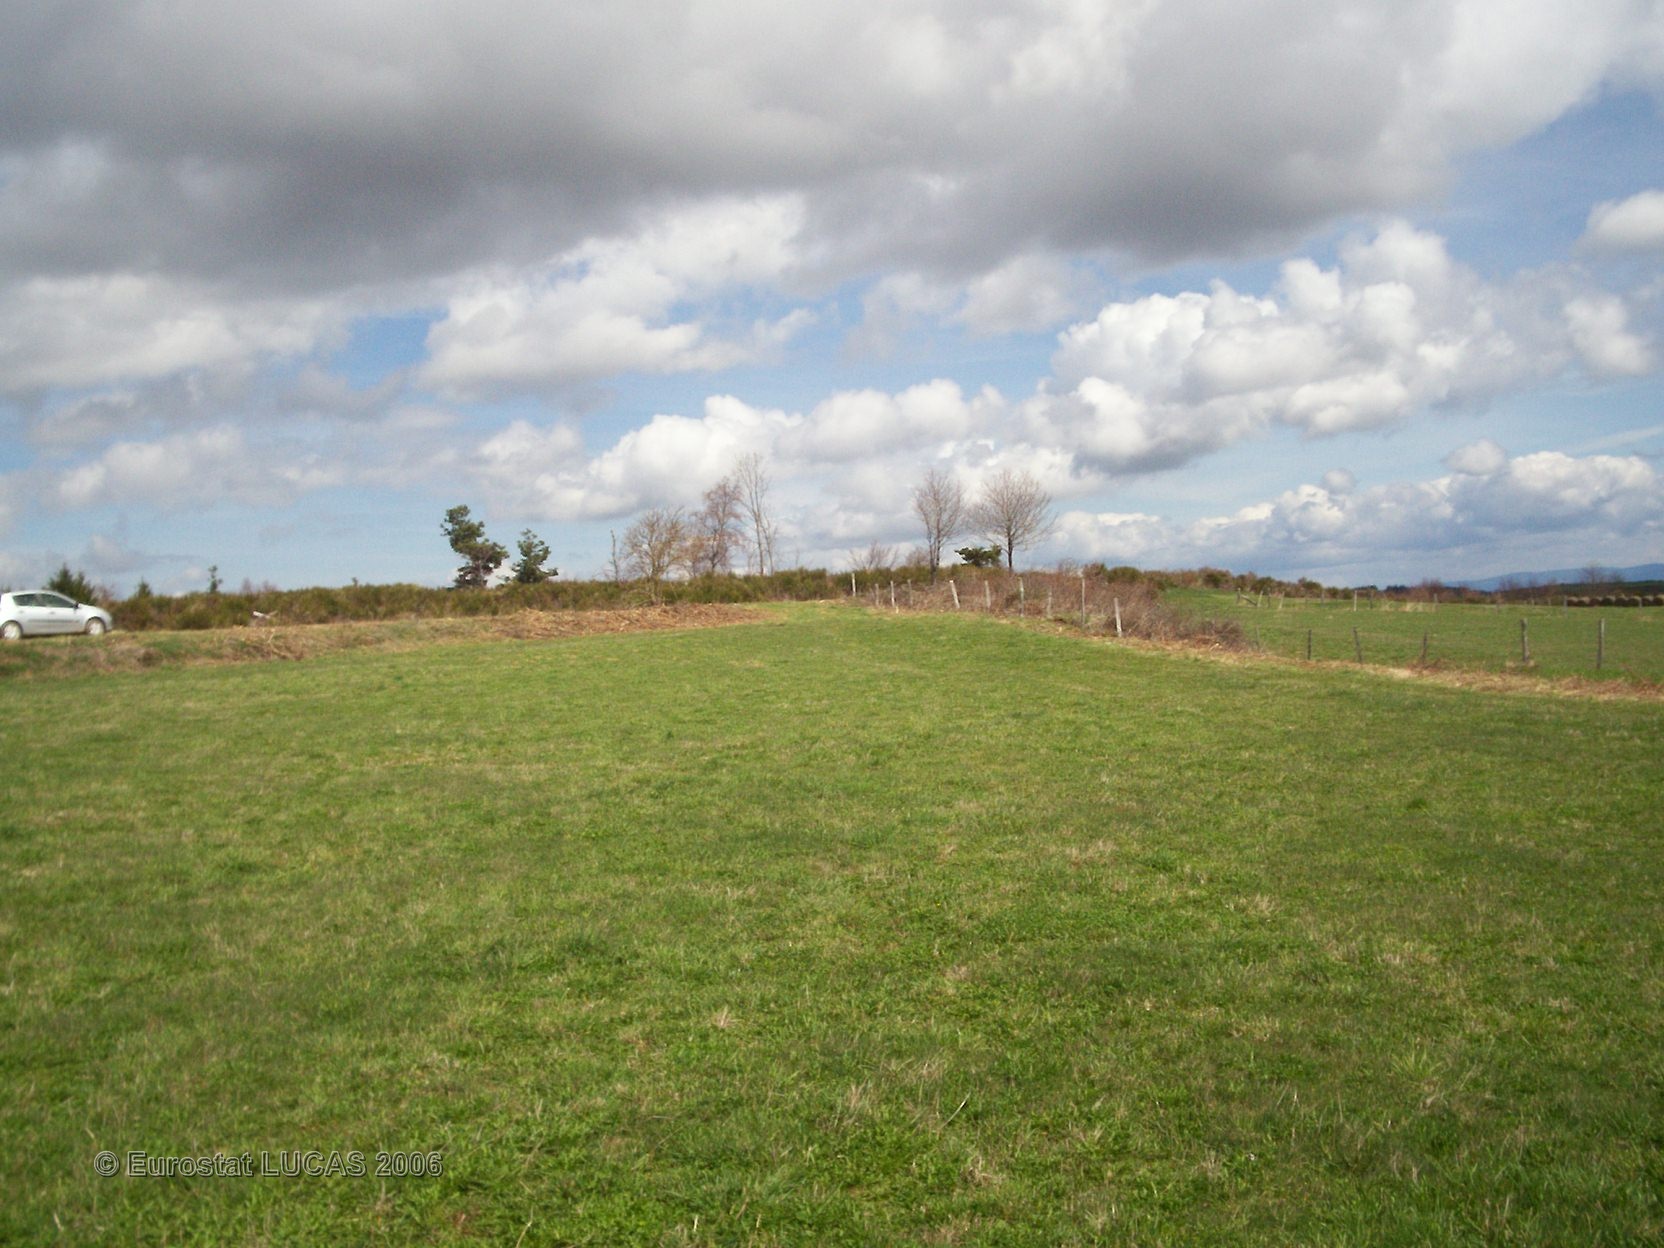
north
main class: Grassland
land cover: Grassland without tree/shrub cover
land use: Agriculture (excluding fallow land and kitchen gardens)
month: April
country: FR
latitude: 45.1109
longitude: 3.3042
